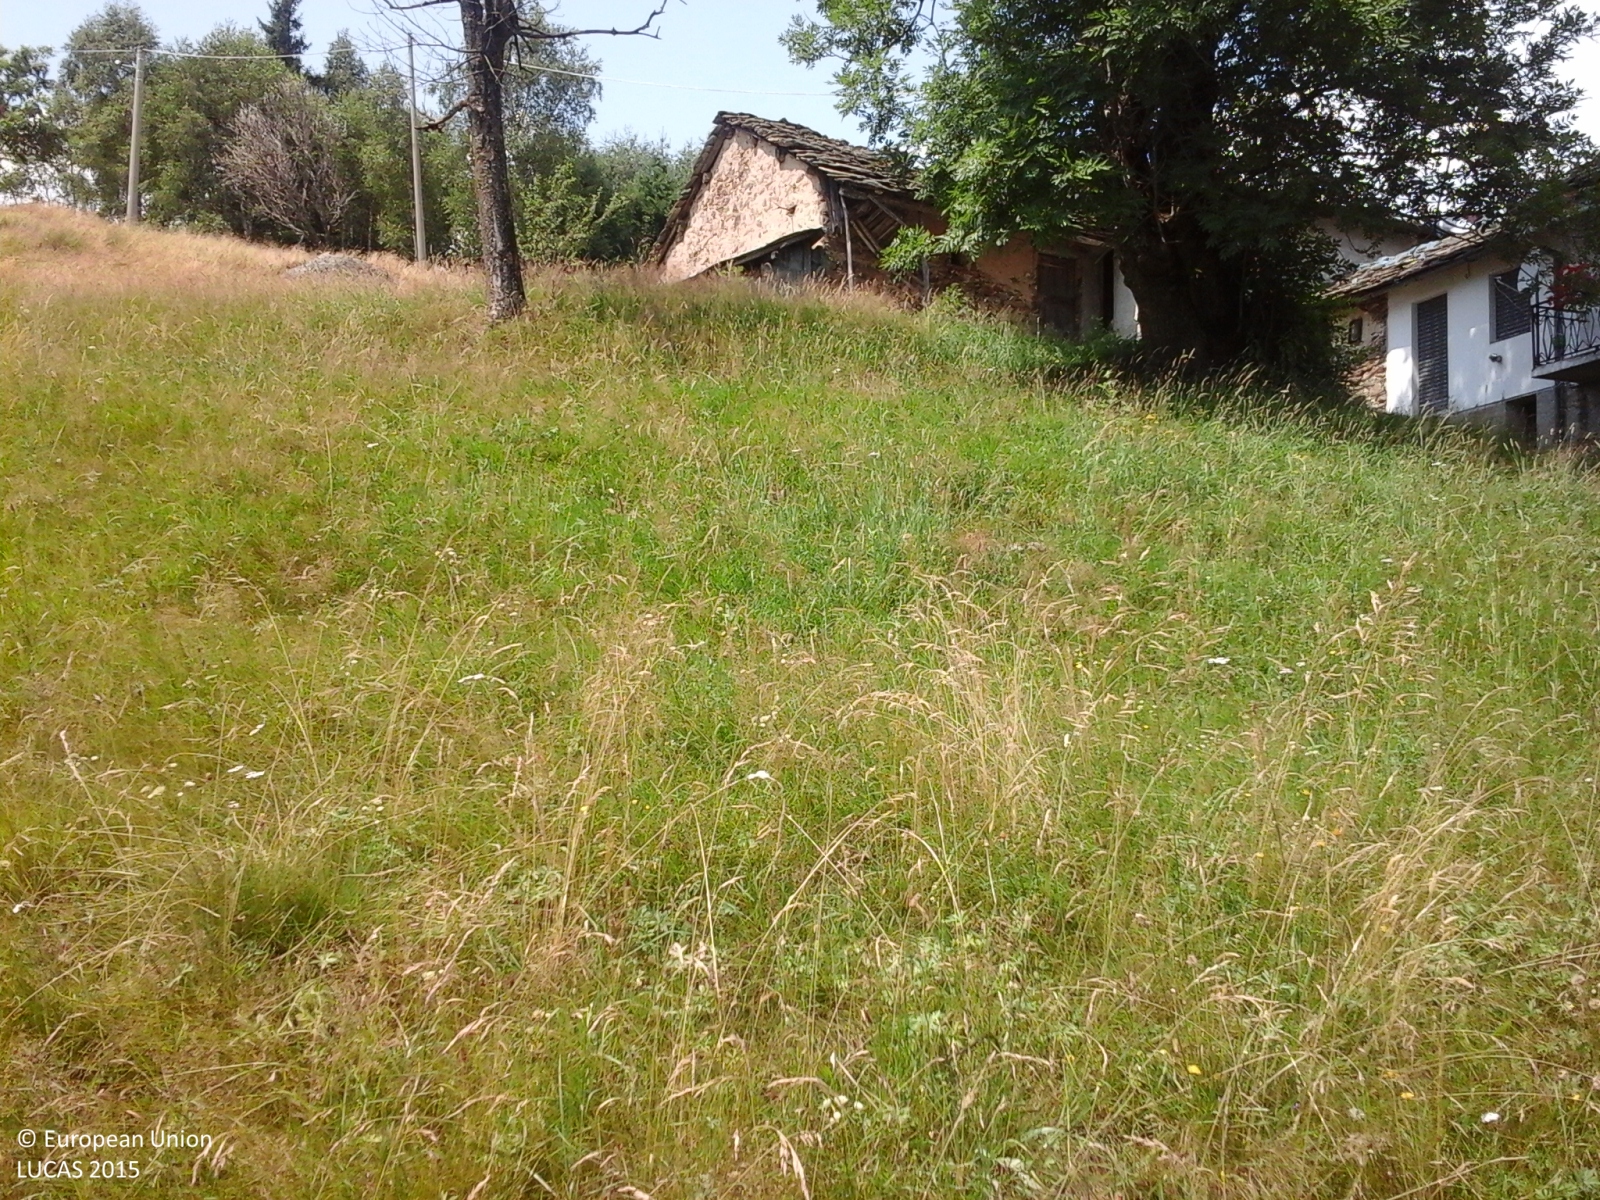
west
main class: Woodland
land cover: Broadleaved woodland
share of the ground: 25 - 50 %
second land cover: Grassland without tree/shrub cover
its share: > 75 %
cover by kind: herbaceous plants 60 %, broadleaved forest trees 40 %
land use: Forestry
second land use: Agriculture (excluding fallow land and kitchen gardens)
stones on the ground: 25 - 50 %
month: July
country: IT
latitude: 45.4425
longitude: 7.6641
